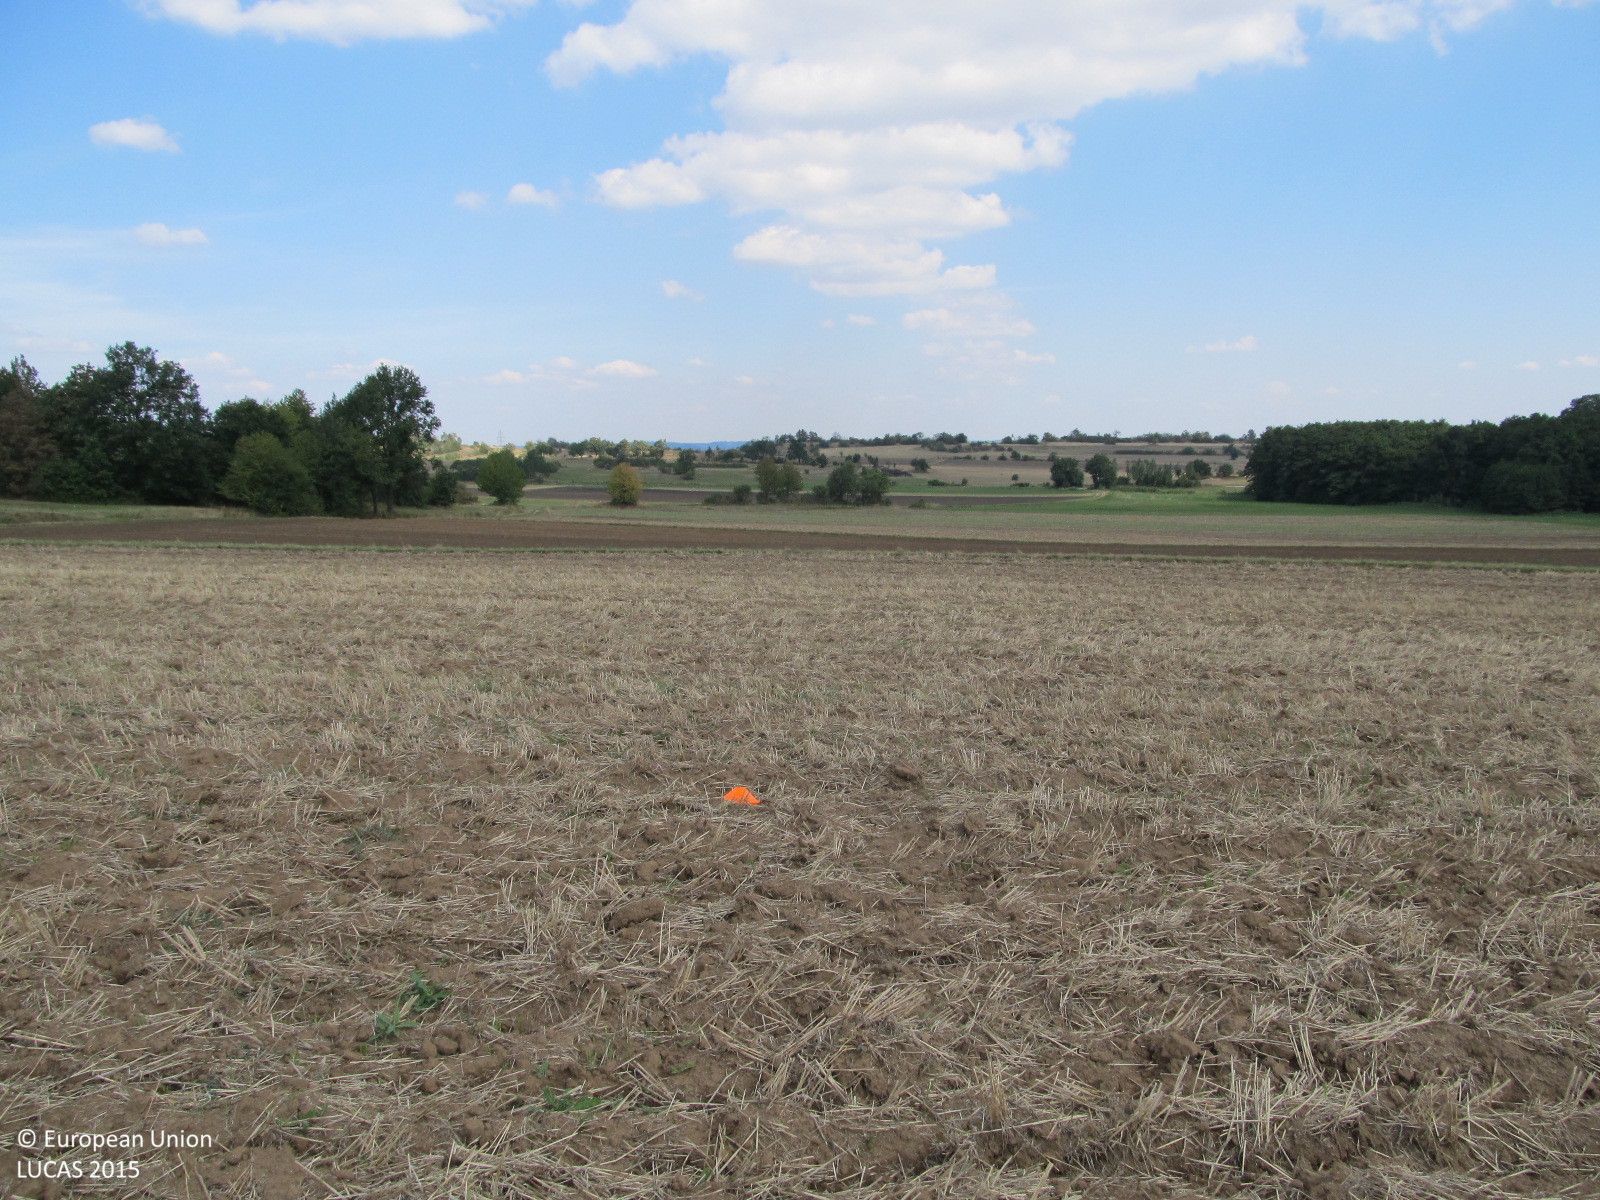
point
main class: Cropland
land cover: Barley
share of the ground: < 10 %
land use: Agriculture (excluding fallow land and kitchen gardens)
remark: Harvested field
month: August
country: AT
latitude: 48.6041
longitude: 15.6041
